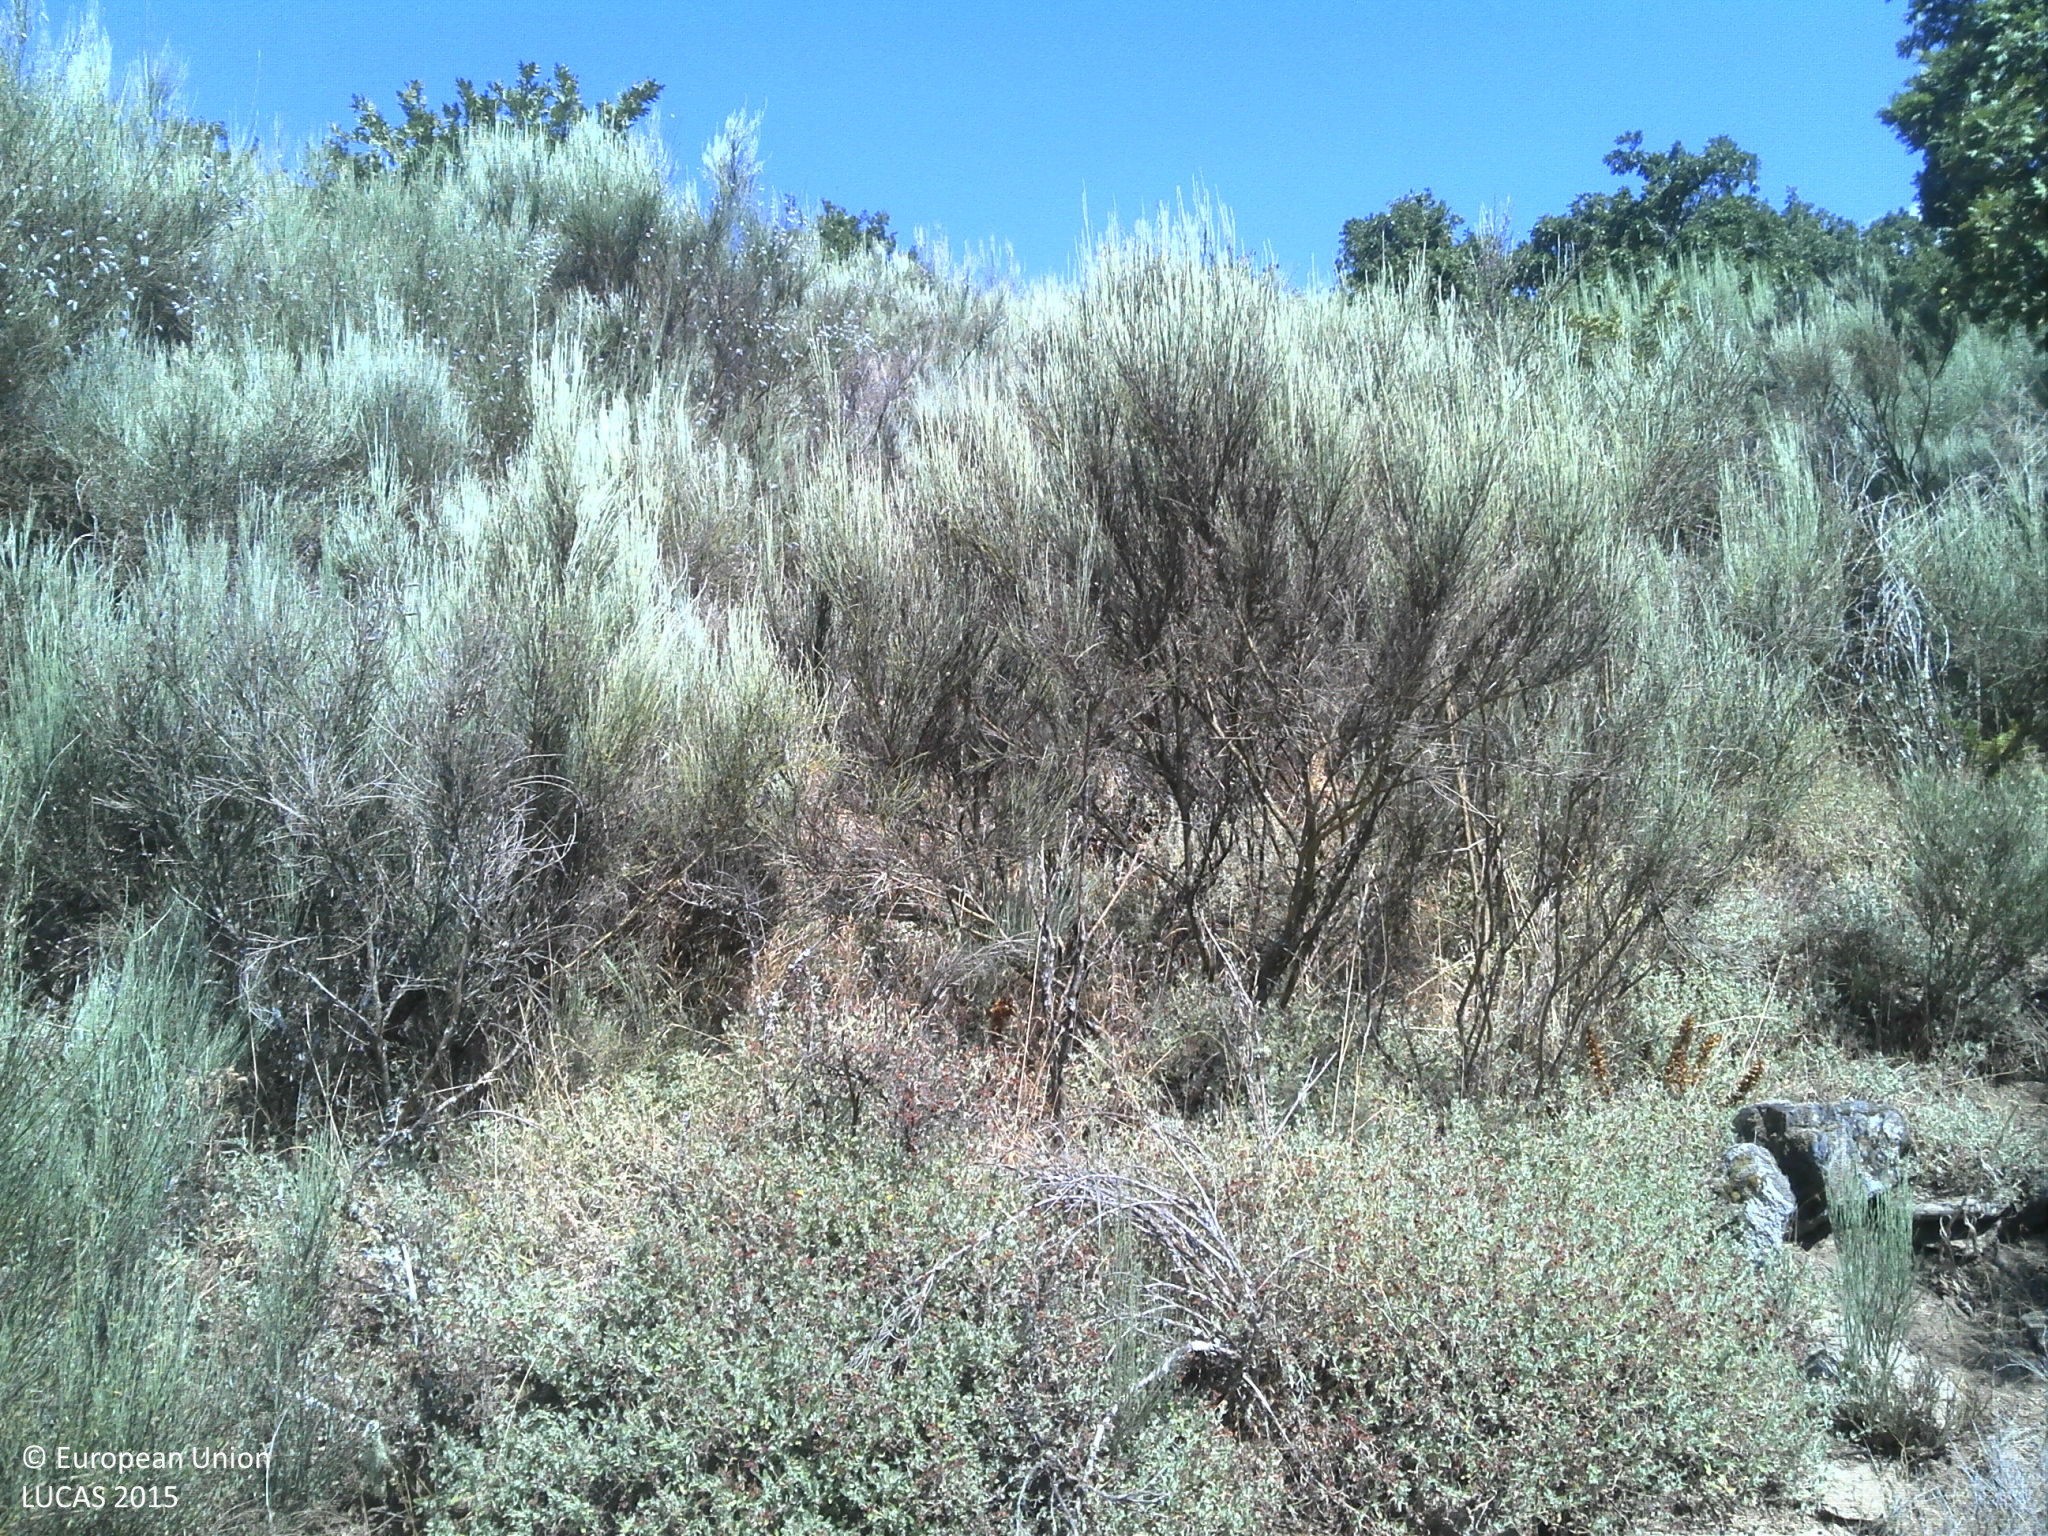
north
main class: Shrubland
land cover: Shrubland without tree cover
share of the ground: 25 - 50 %
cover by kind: shrubs 45 %, unconsolidated bare surface 30 %, herbaceous plants 15 %
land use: Semi-natural and natural areas not in use
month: August
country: PT
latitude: 40.5088
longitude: -7.4943
